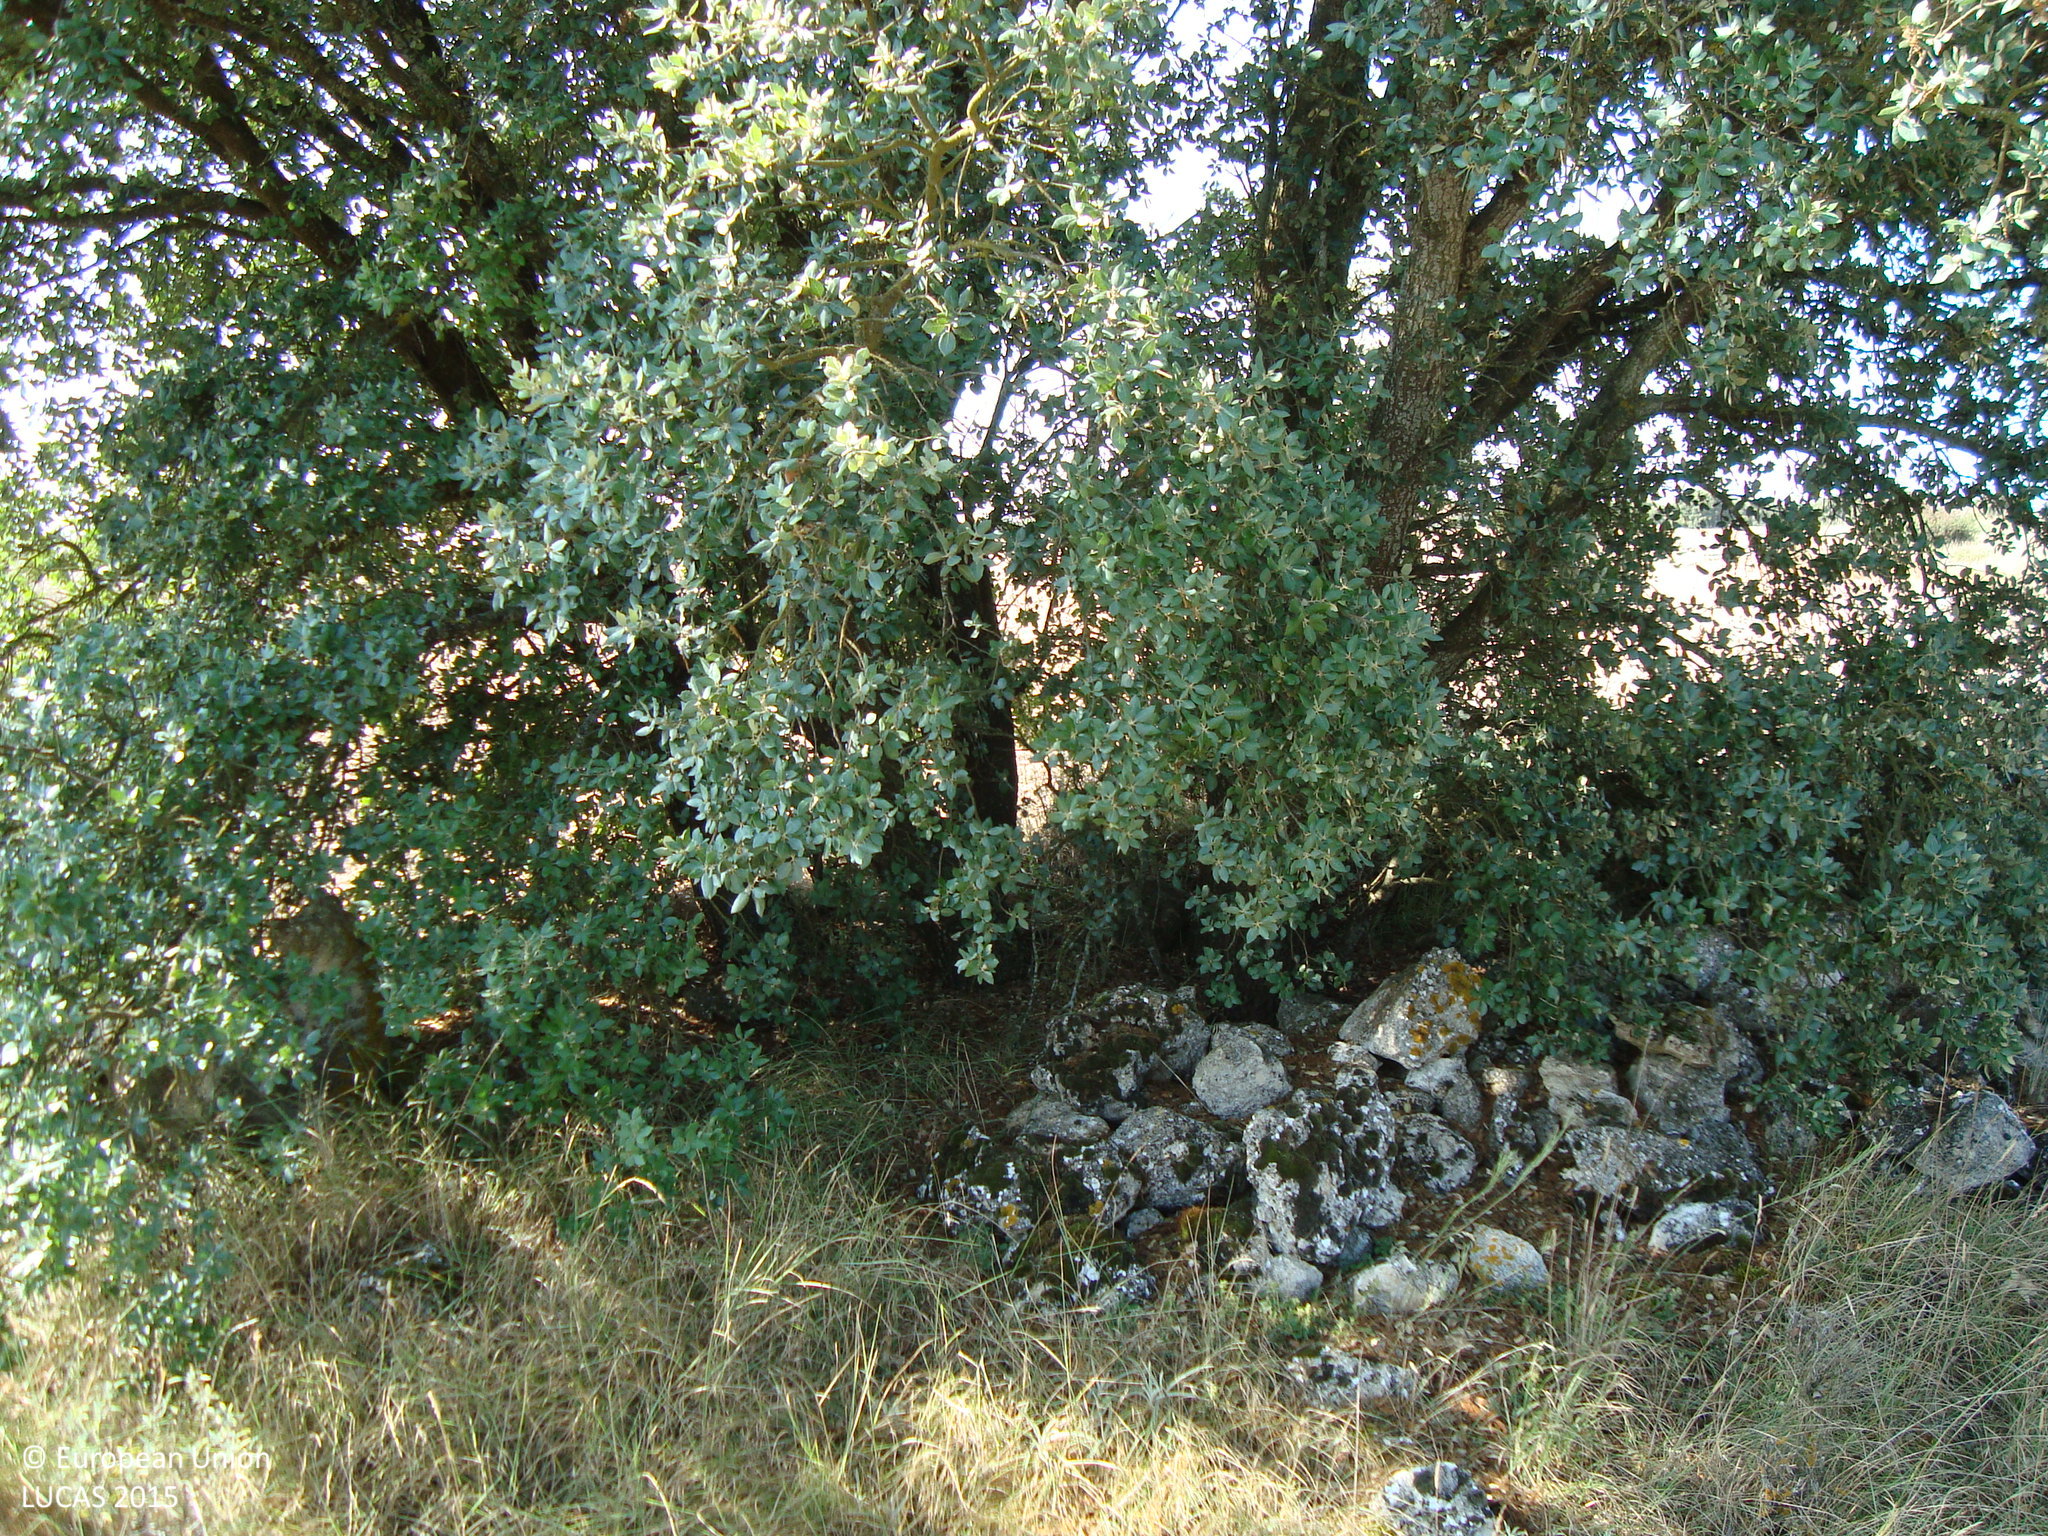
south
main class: Woodland
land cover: Broadleaved woodland
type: broadleaved evergreen forest
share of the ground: 10 - 25 %
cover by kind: unconsolidated bare surface 40 %, herbaceous plants 30 %, broadleaved forest trees 15 %, shrubs 10 %
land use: Forestry
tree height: > 5 m
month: July
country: ES
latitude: 41.7940
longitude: -4.2021
